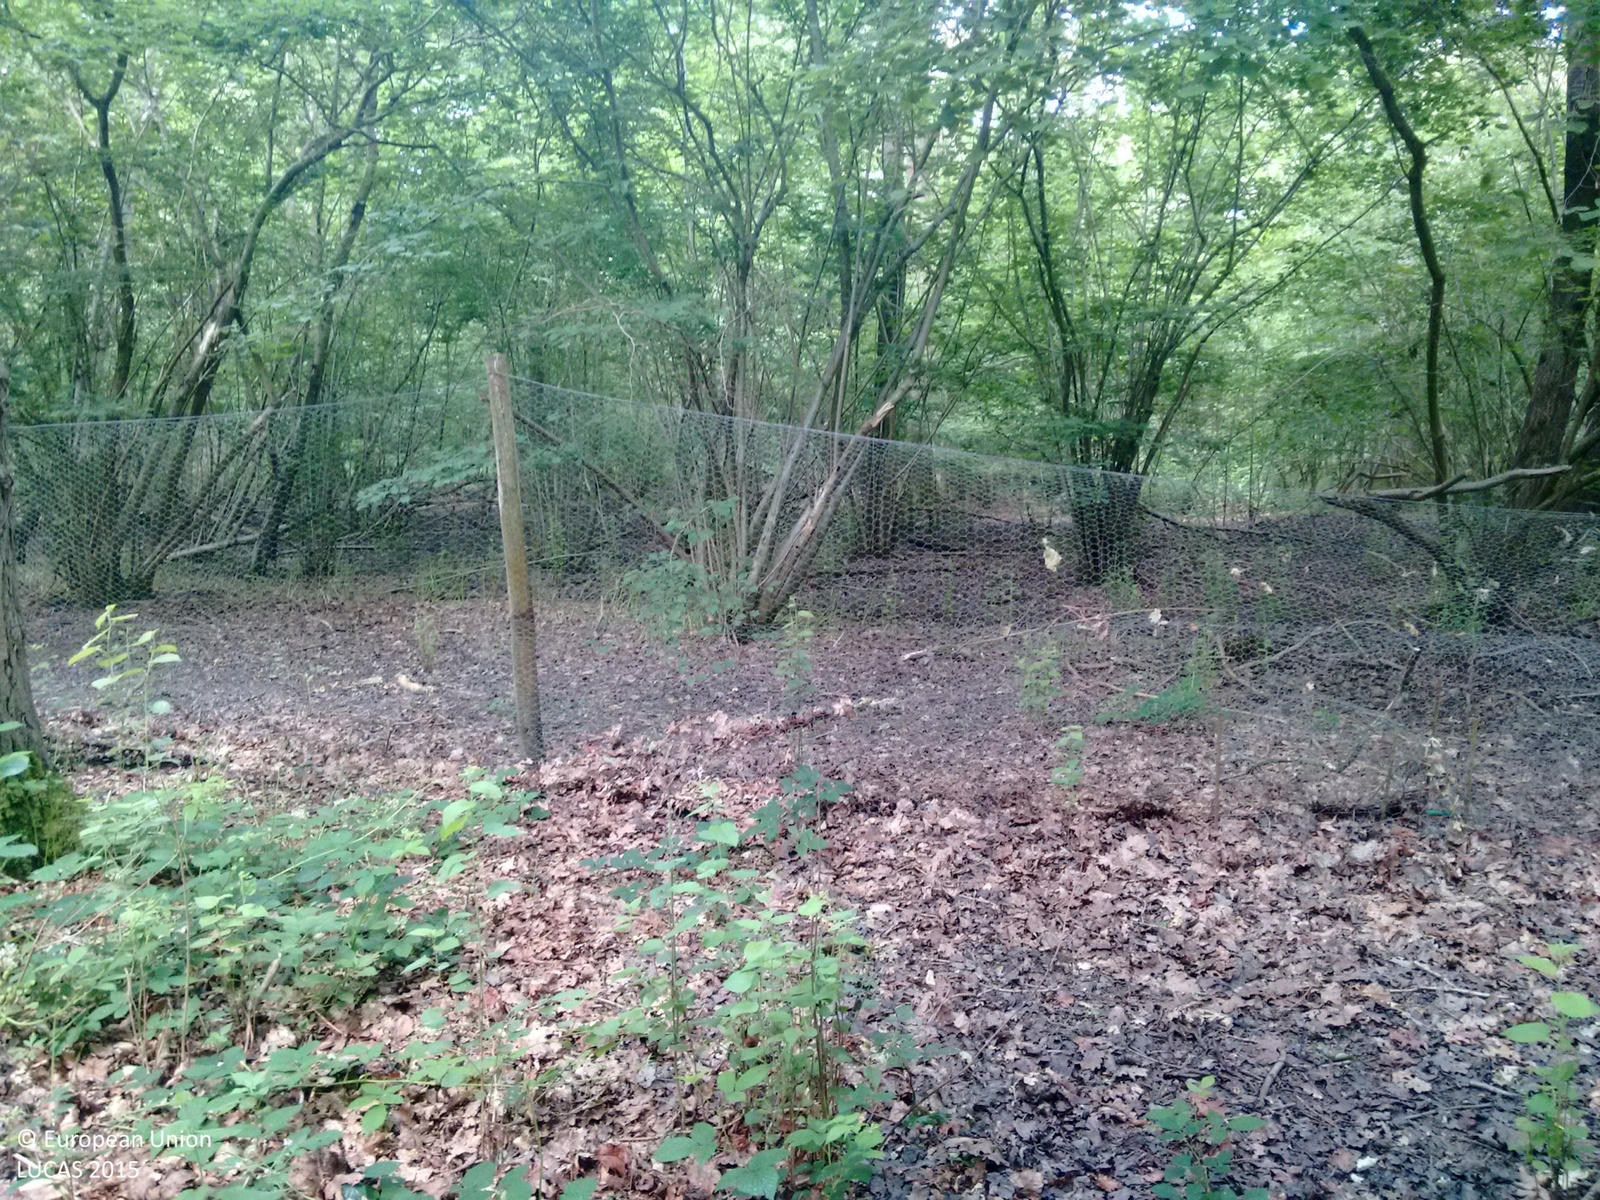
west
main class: Woodland
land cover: Broadleaved woodland
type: mesophytic deciduous forest
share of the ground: > 75 %
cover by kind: broadleaved forest trees 90 %, shrubs 10 %
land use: Semi-natural and natural areas not in use
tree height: > 5 m
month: July
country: GB
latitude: 50.9541
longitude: -0.0408
